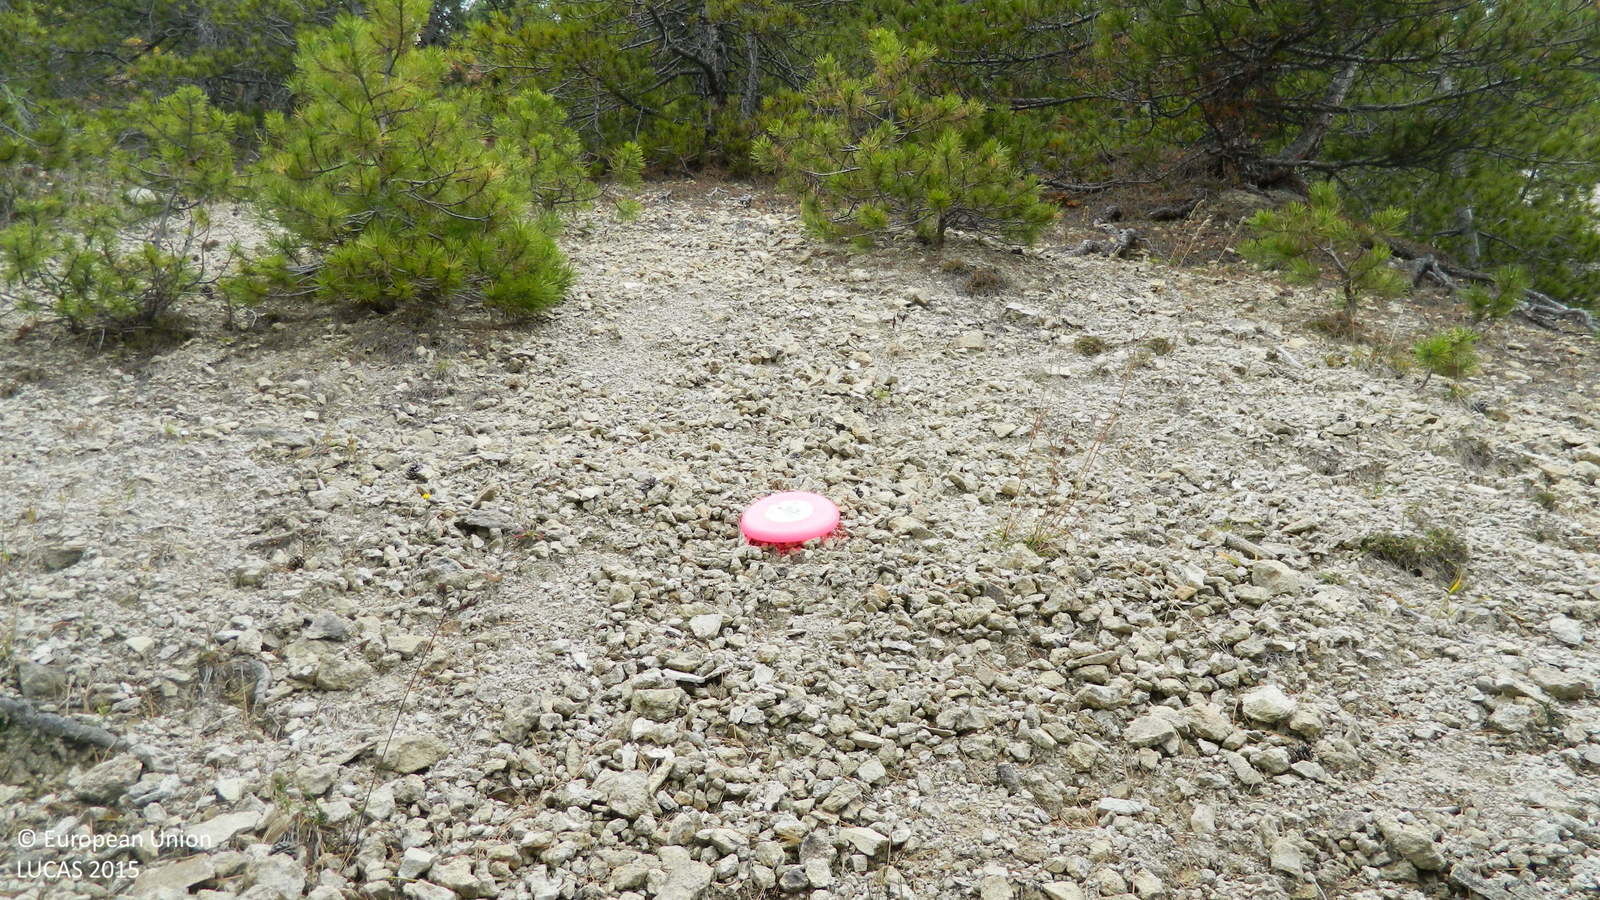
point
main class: Woodland
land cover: Pine dominated coniferous woodland
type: alpine coniferous forest
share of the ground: 50 - 75 %
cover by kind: coniferous forest trees 70 %, unconsolidated bare surface 30 %
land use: Forestry
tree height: > 5 m
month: November
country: BG
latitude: 41.8346
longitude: 25.0450
